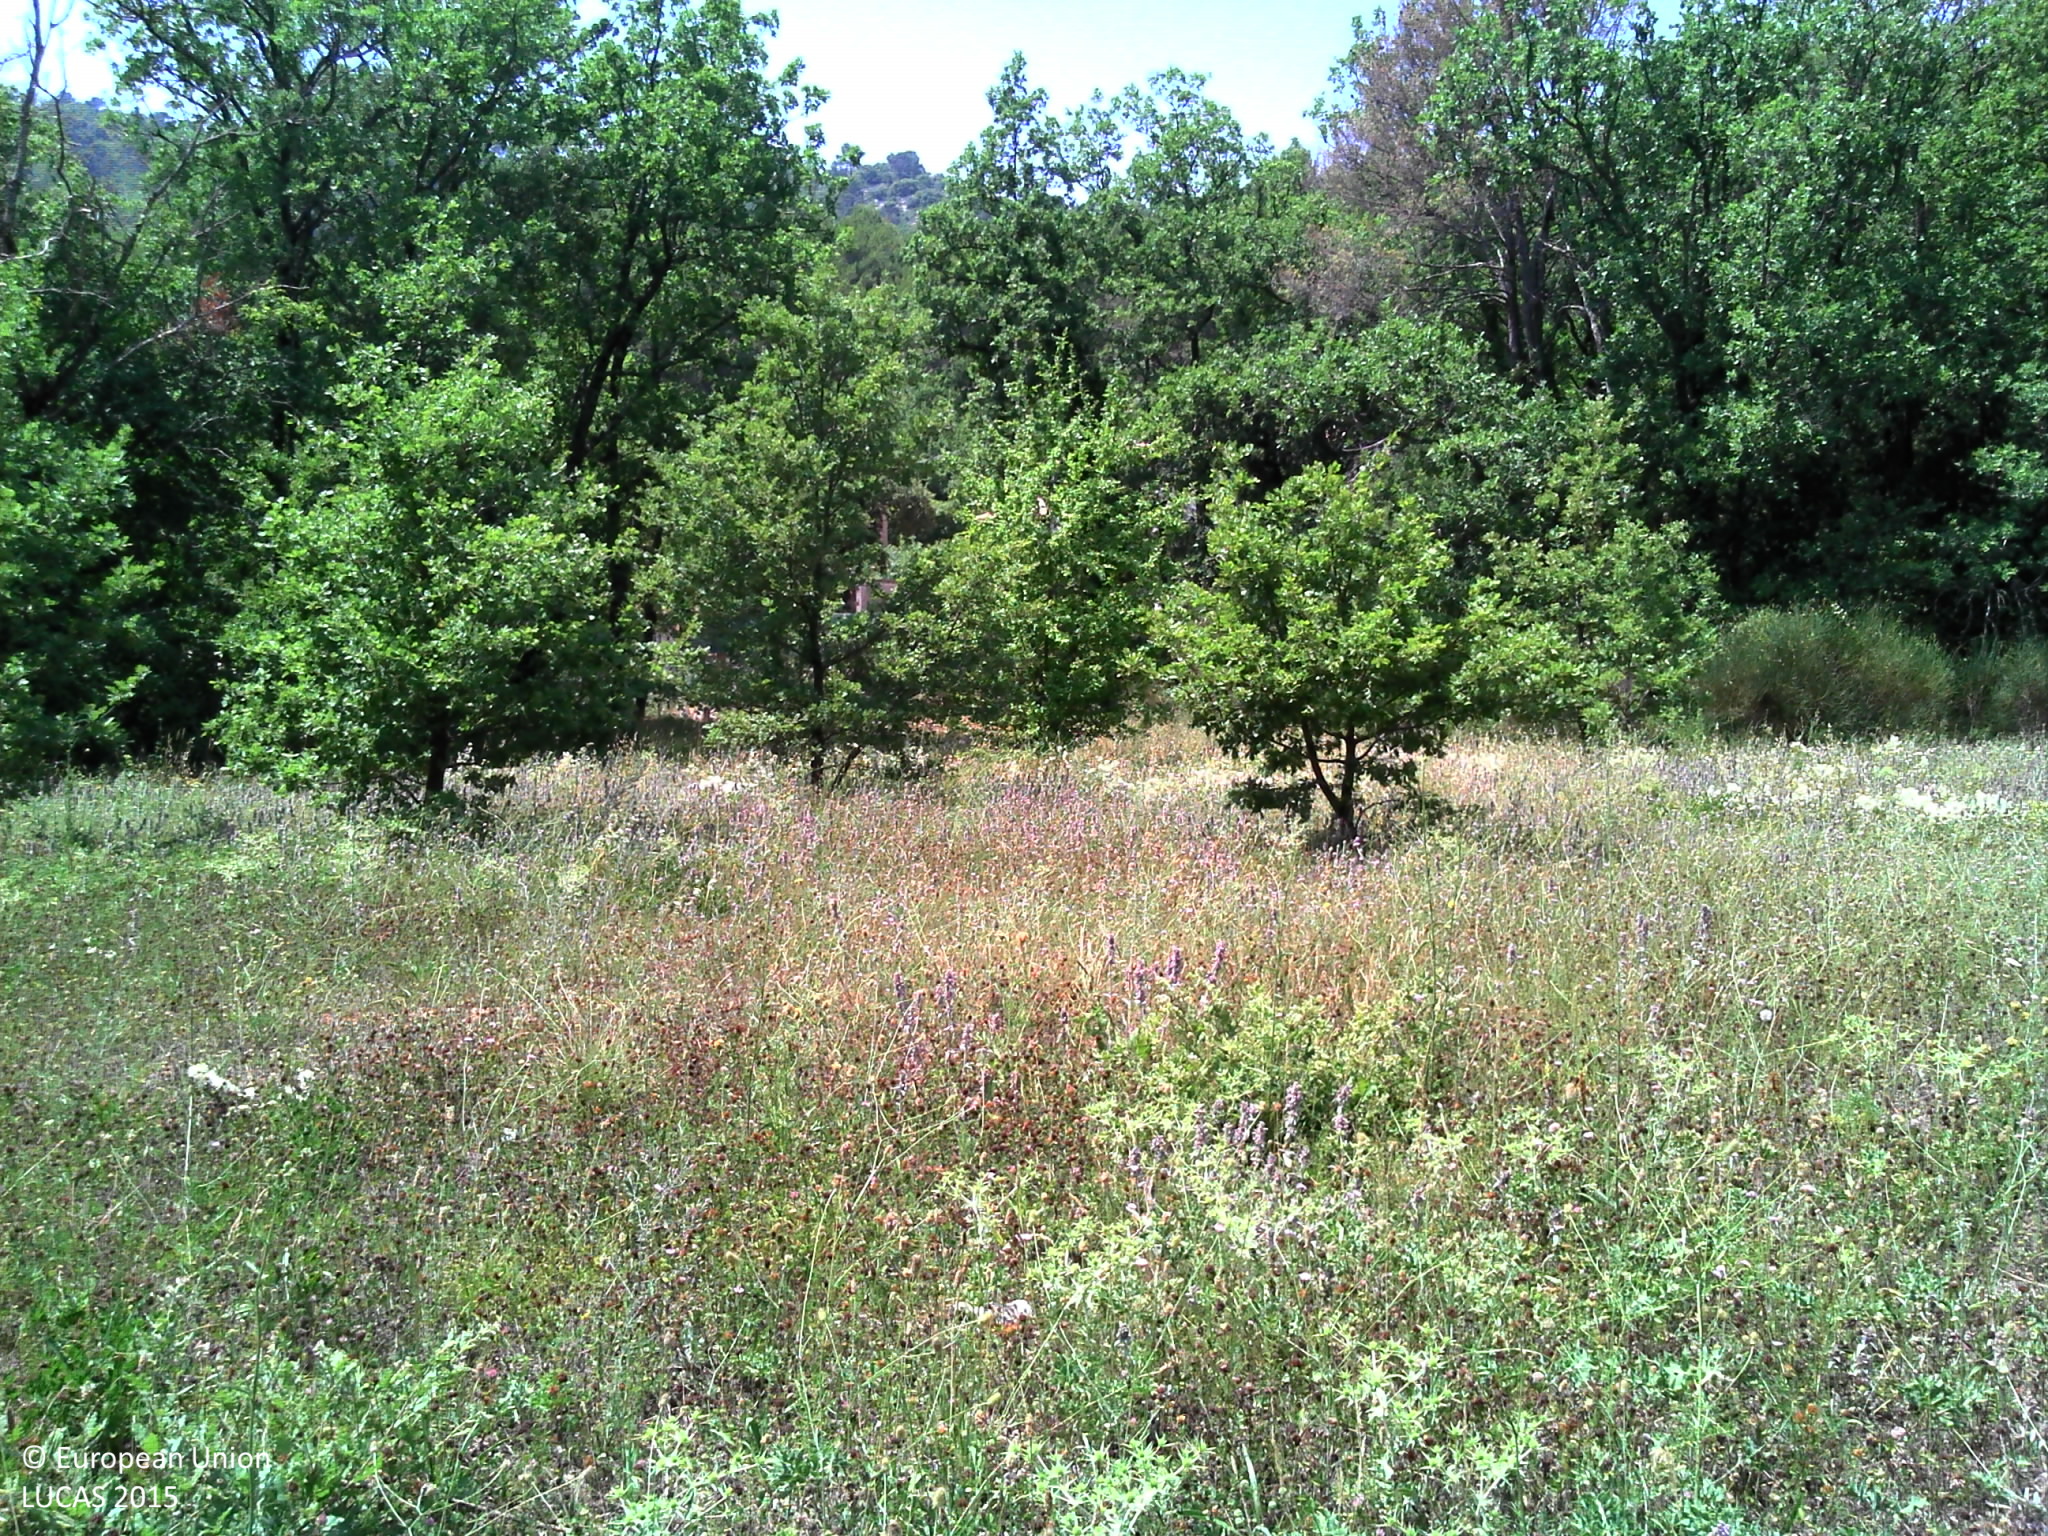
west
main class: Grassland
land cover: Grassland with sparse tree/shrub cover
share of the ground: > 75 %
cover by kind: herbaceous plants 95 %, broadleaved forest trees 5 %
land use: Semi-natural and natural areas not in use
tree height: < 5 m
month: July
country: FR
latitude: 43.3614
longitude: 5.7774
